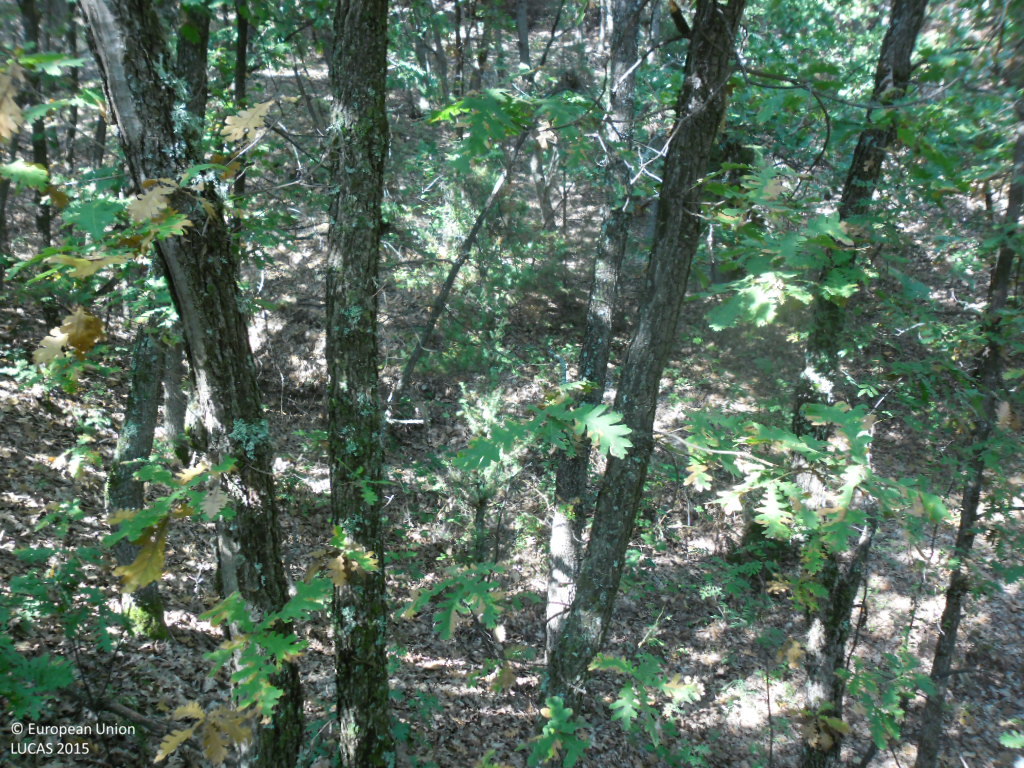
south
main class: Woodland
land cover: Broadleaved woodland
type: mesophytic deciduous forest
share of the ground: > 75 %
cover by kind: broadleaved forest trees 95 %, unconsolidated bare surface 5 %
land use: Forestry
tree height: < 5 m
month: September
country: BG
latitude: 41.9092
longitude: 22.9571
